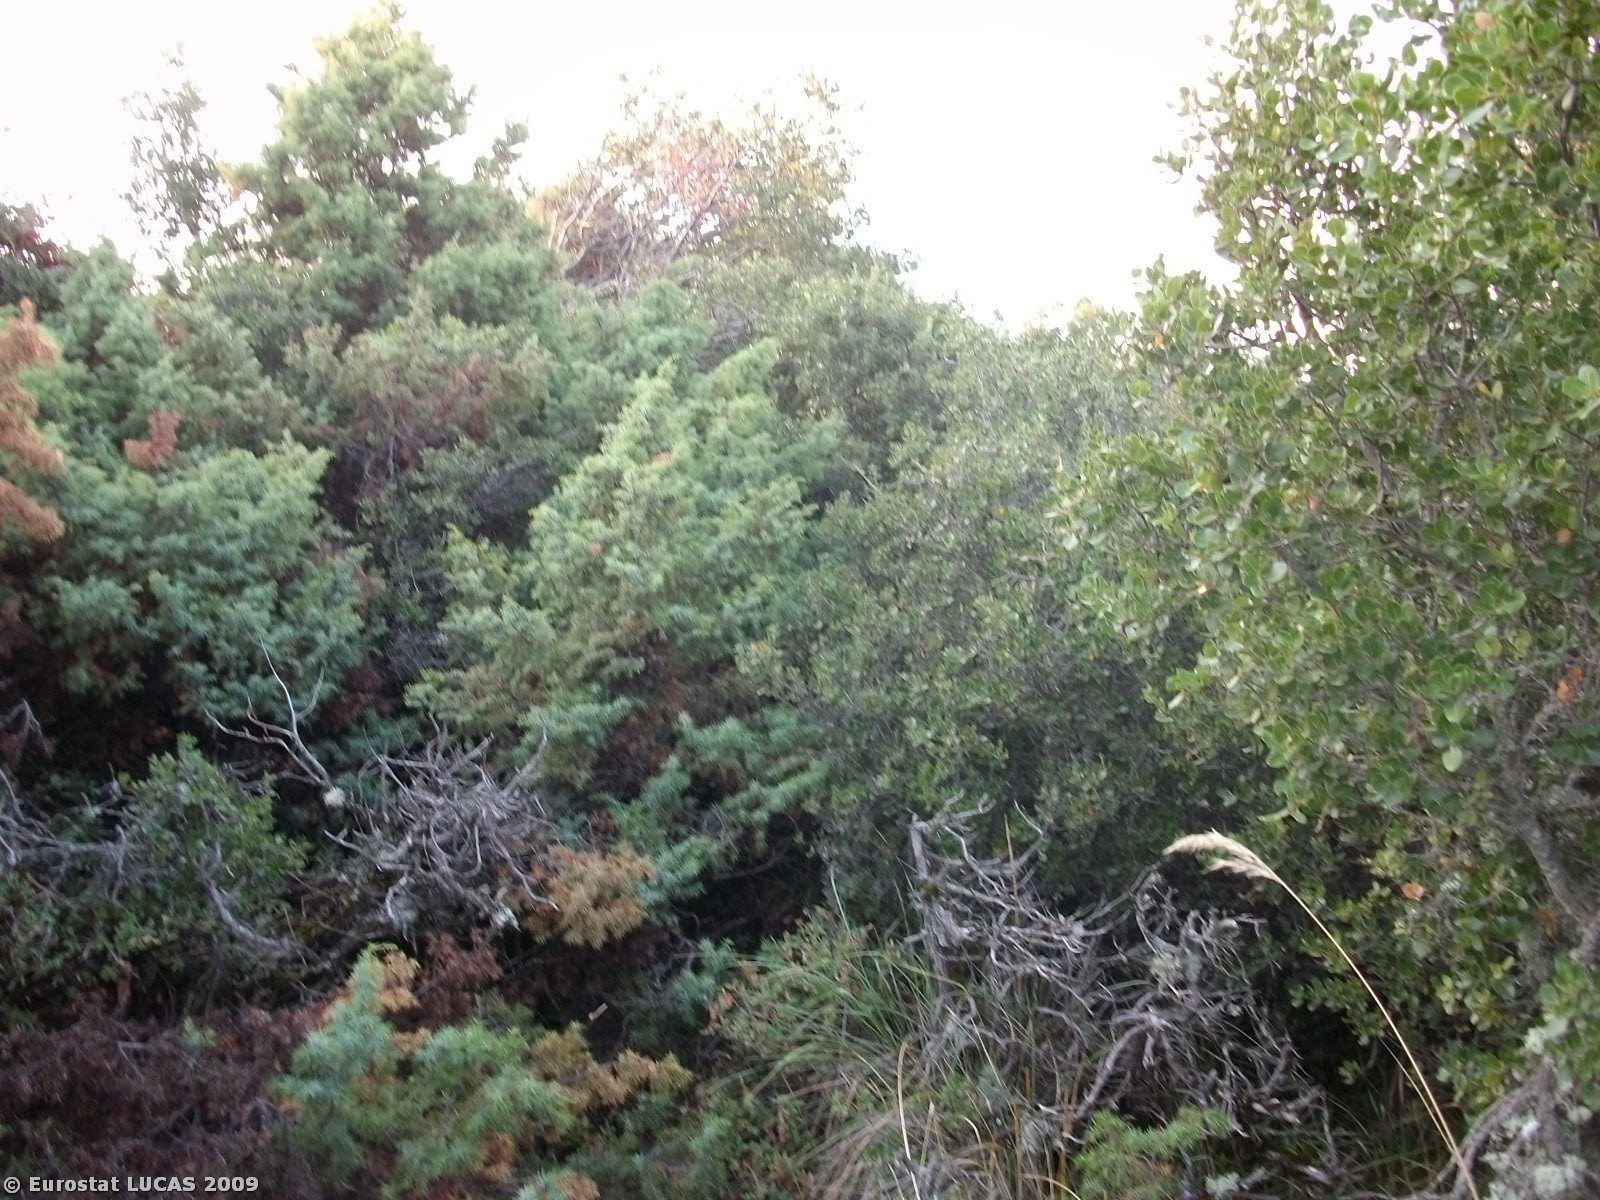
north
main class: Shrubland
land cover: Shrubland without tree cover
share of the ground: > 75 %
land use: Unused
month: August
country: GR
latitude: 38.9758
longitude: 22.4596
